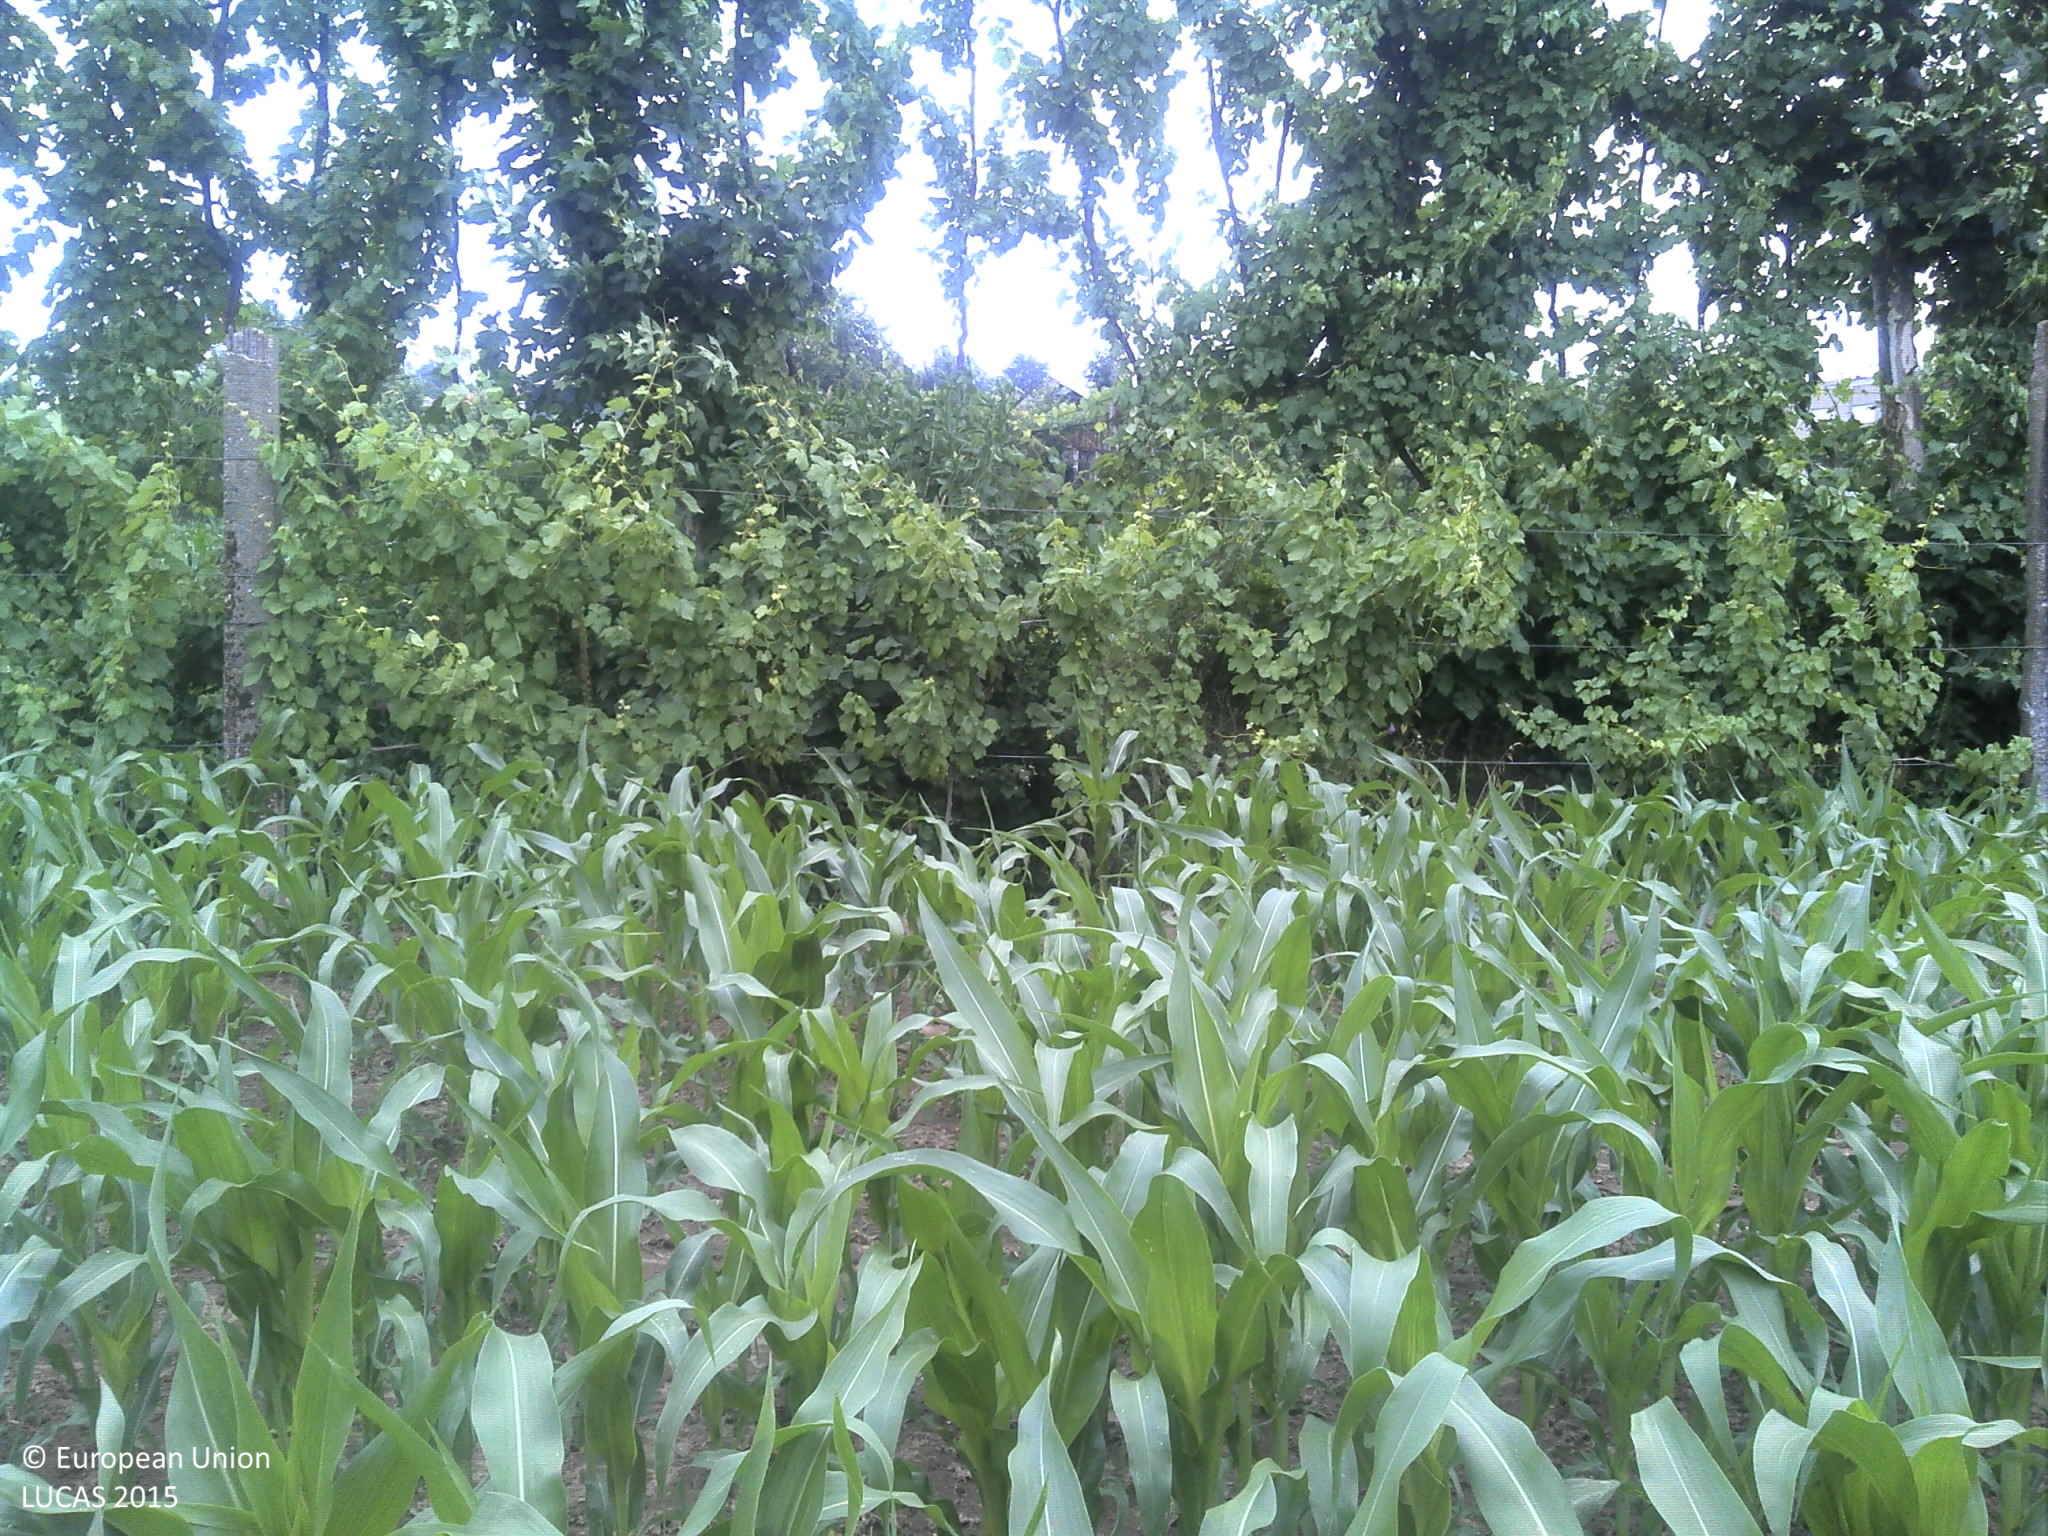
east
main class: Cropland
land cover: Maize
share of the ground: > 75 %
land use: Agriculture (excluding fallow land and kitchen gardens)
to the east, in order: Maize; Vineyards; Abandoned hedges; Rivers and streams; Vineyards; Maize; Vineyards; Artificial constructions in urban areas
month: June
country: PT
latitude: 41.2958
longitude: -8.2363
